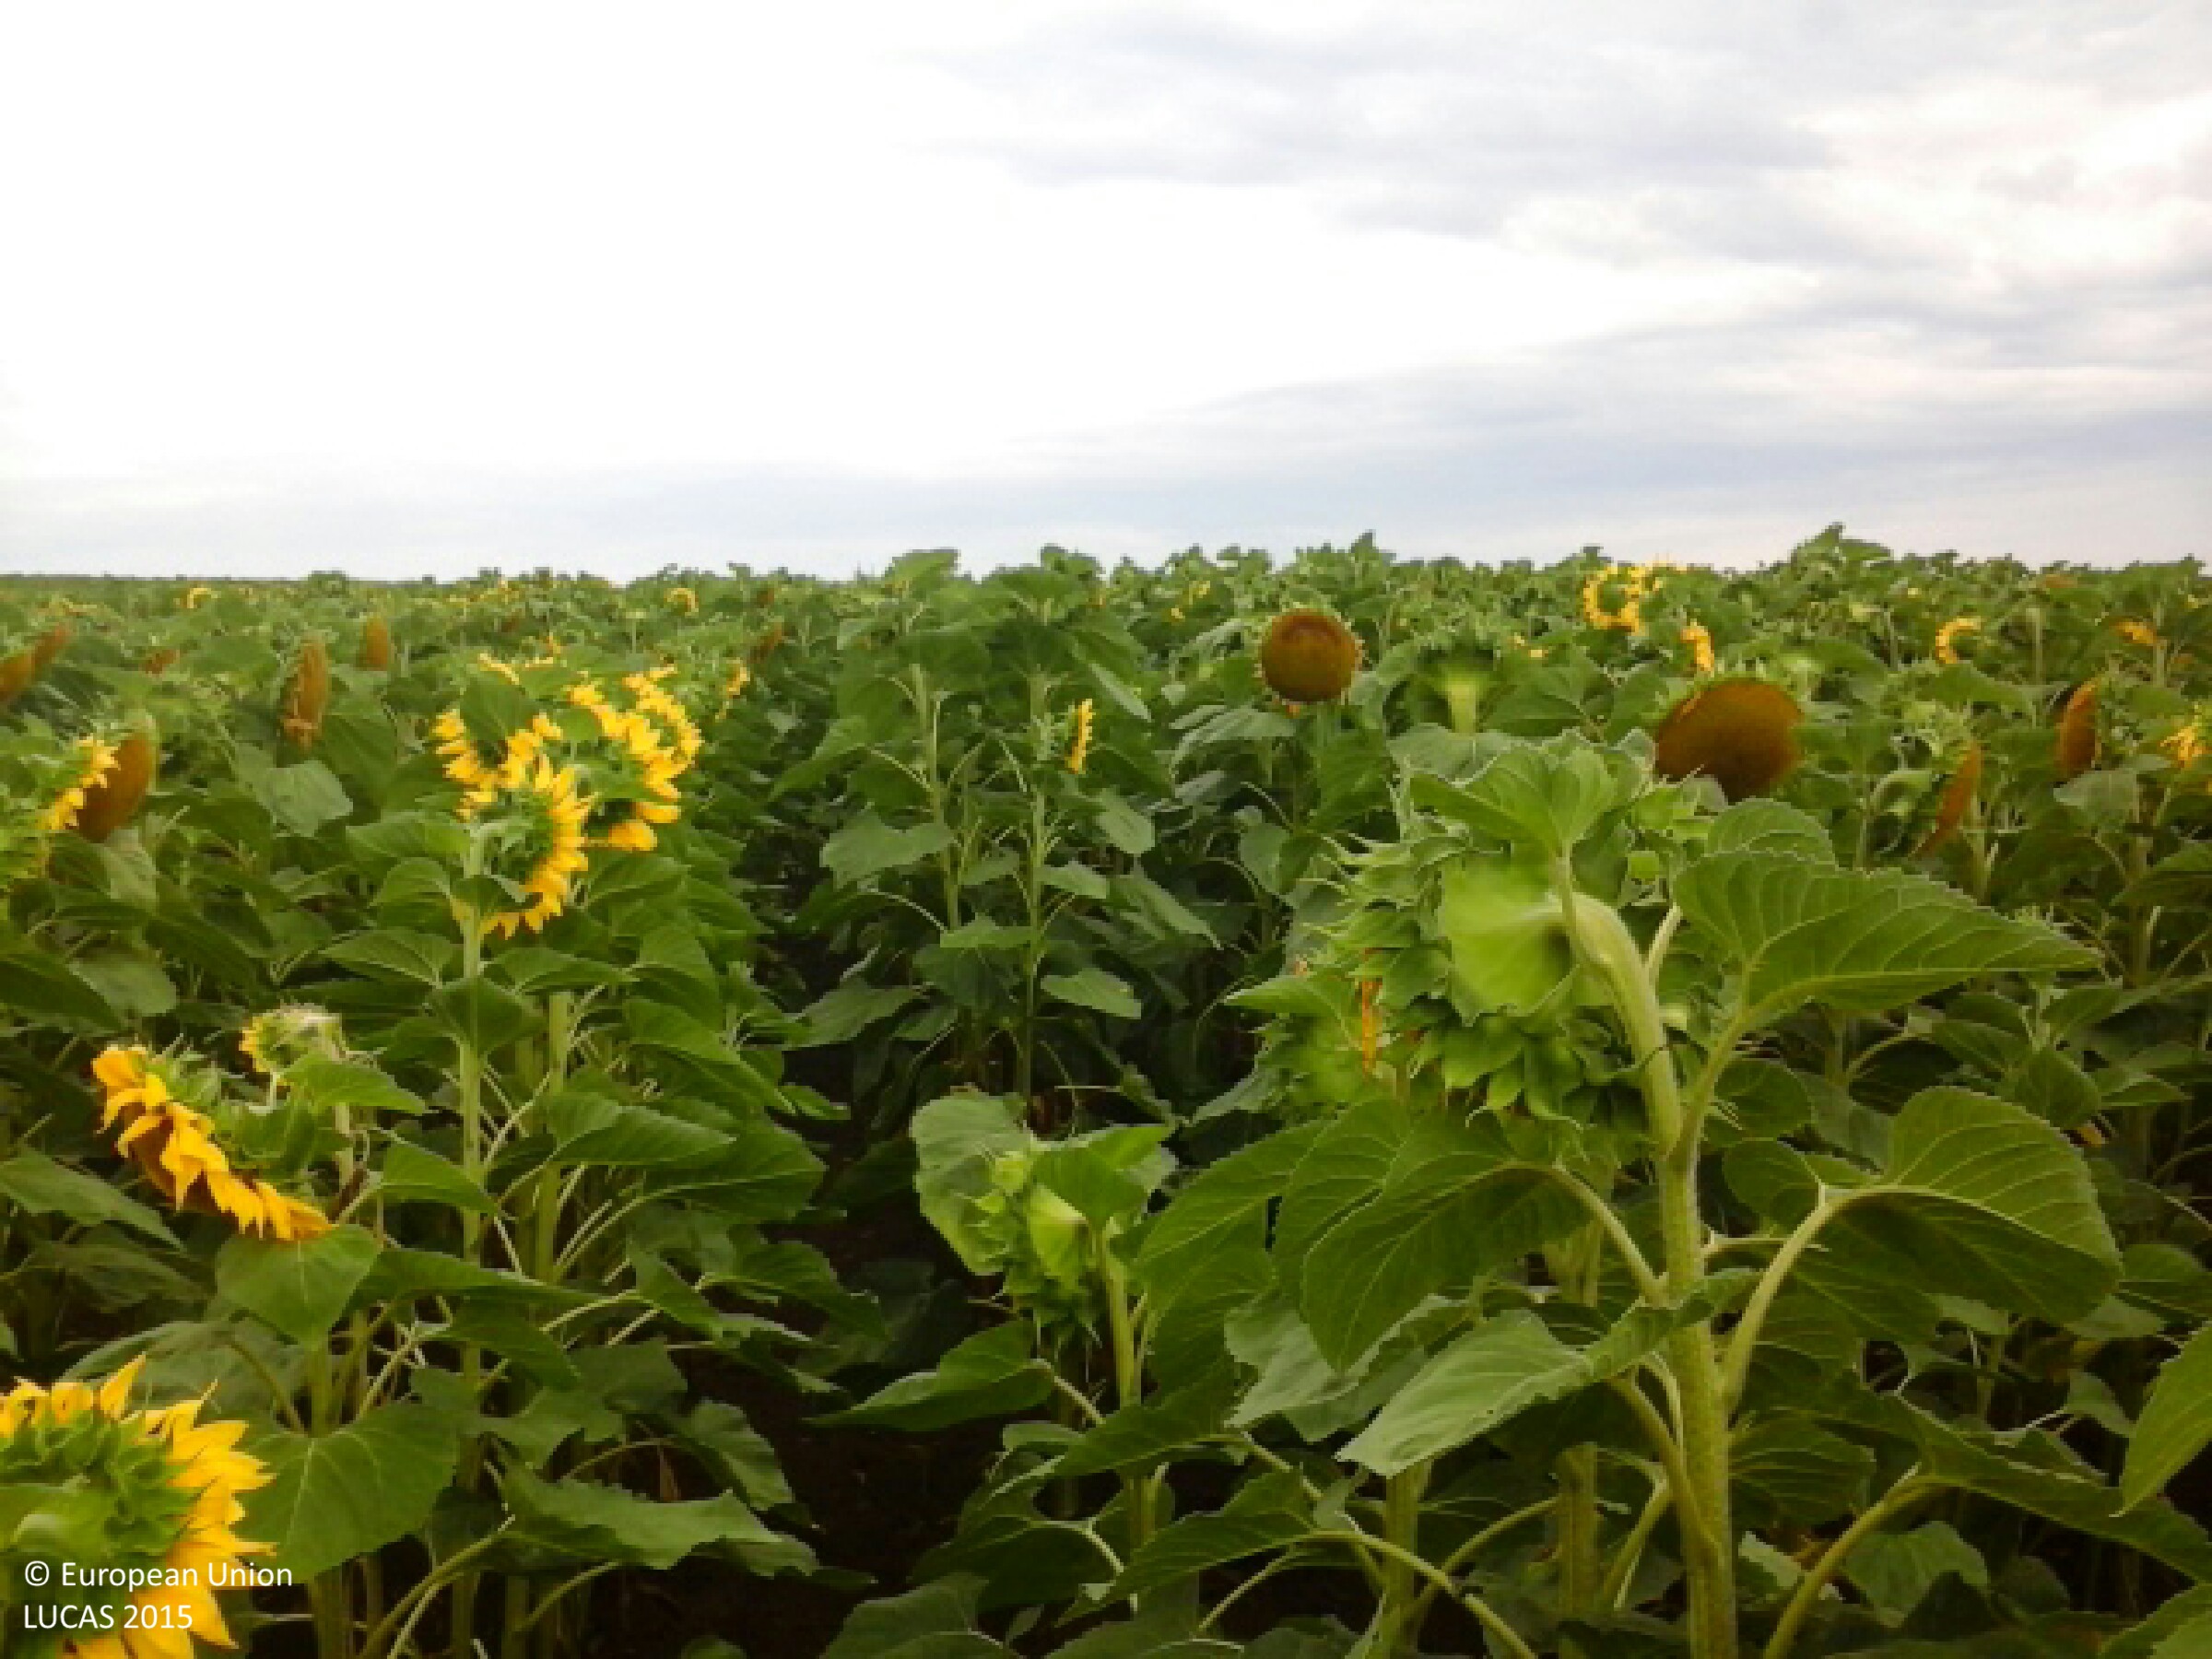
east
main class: Cropland
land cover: Sunflower
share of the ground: > 75 %
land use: Agriculture (excluding fallow land and kitchen gardens)
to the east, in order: Sunflower
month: July
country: HU
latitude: 48.3653
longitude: 20.9596
